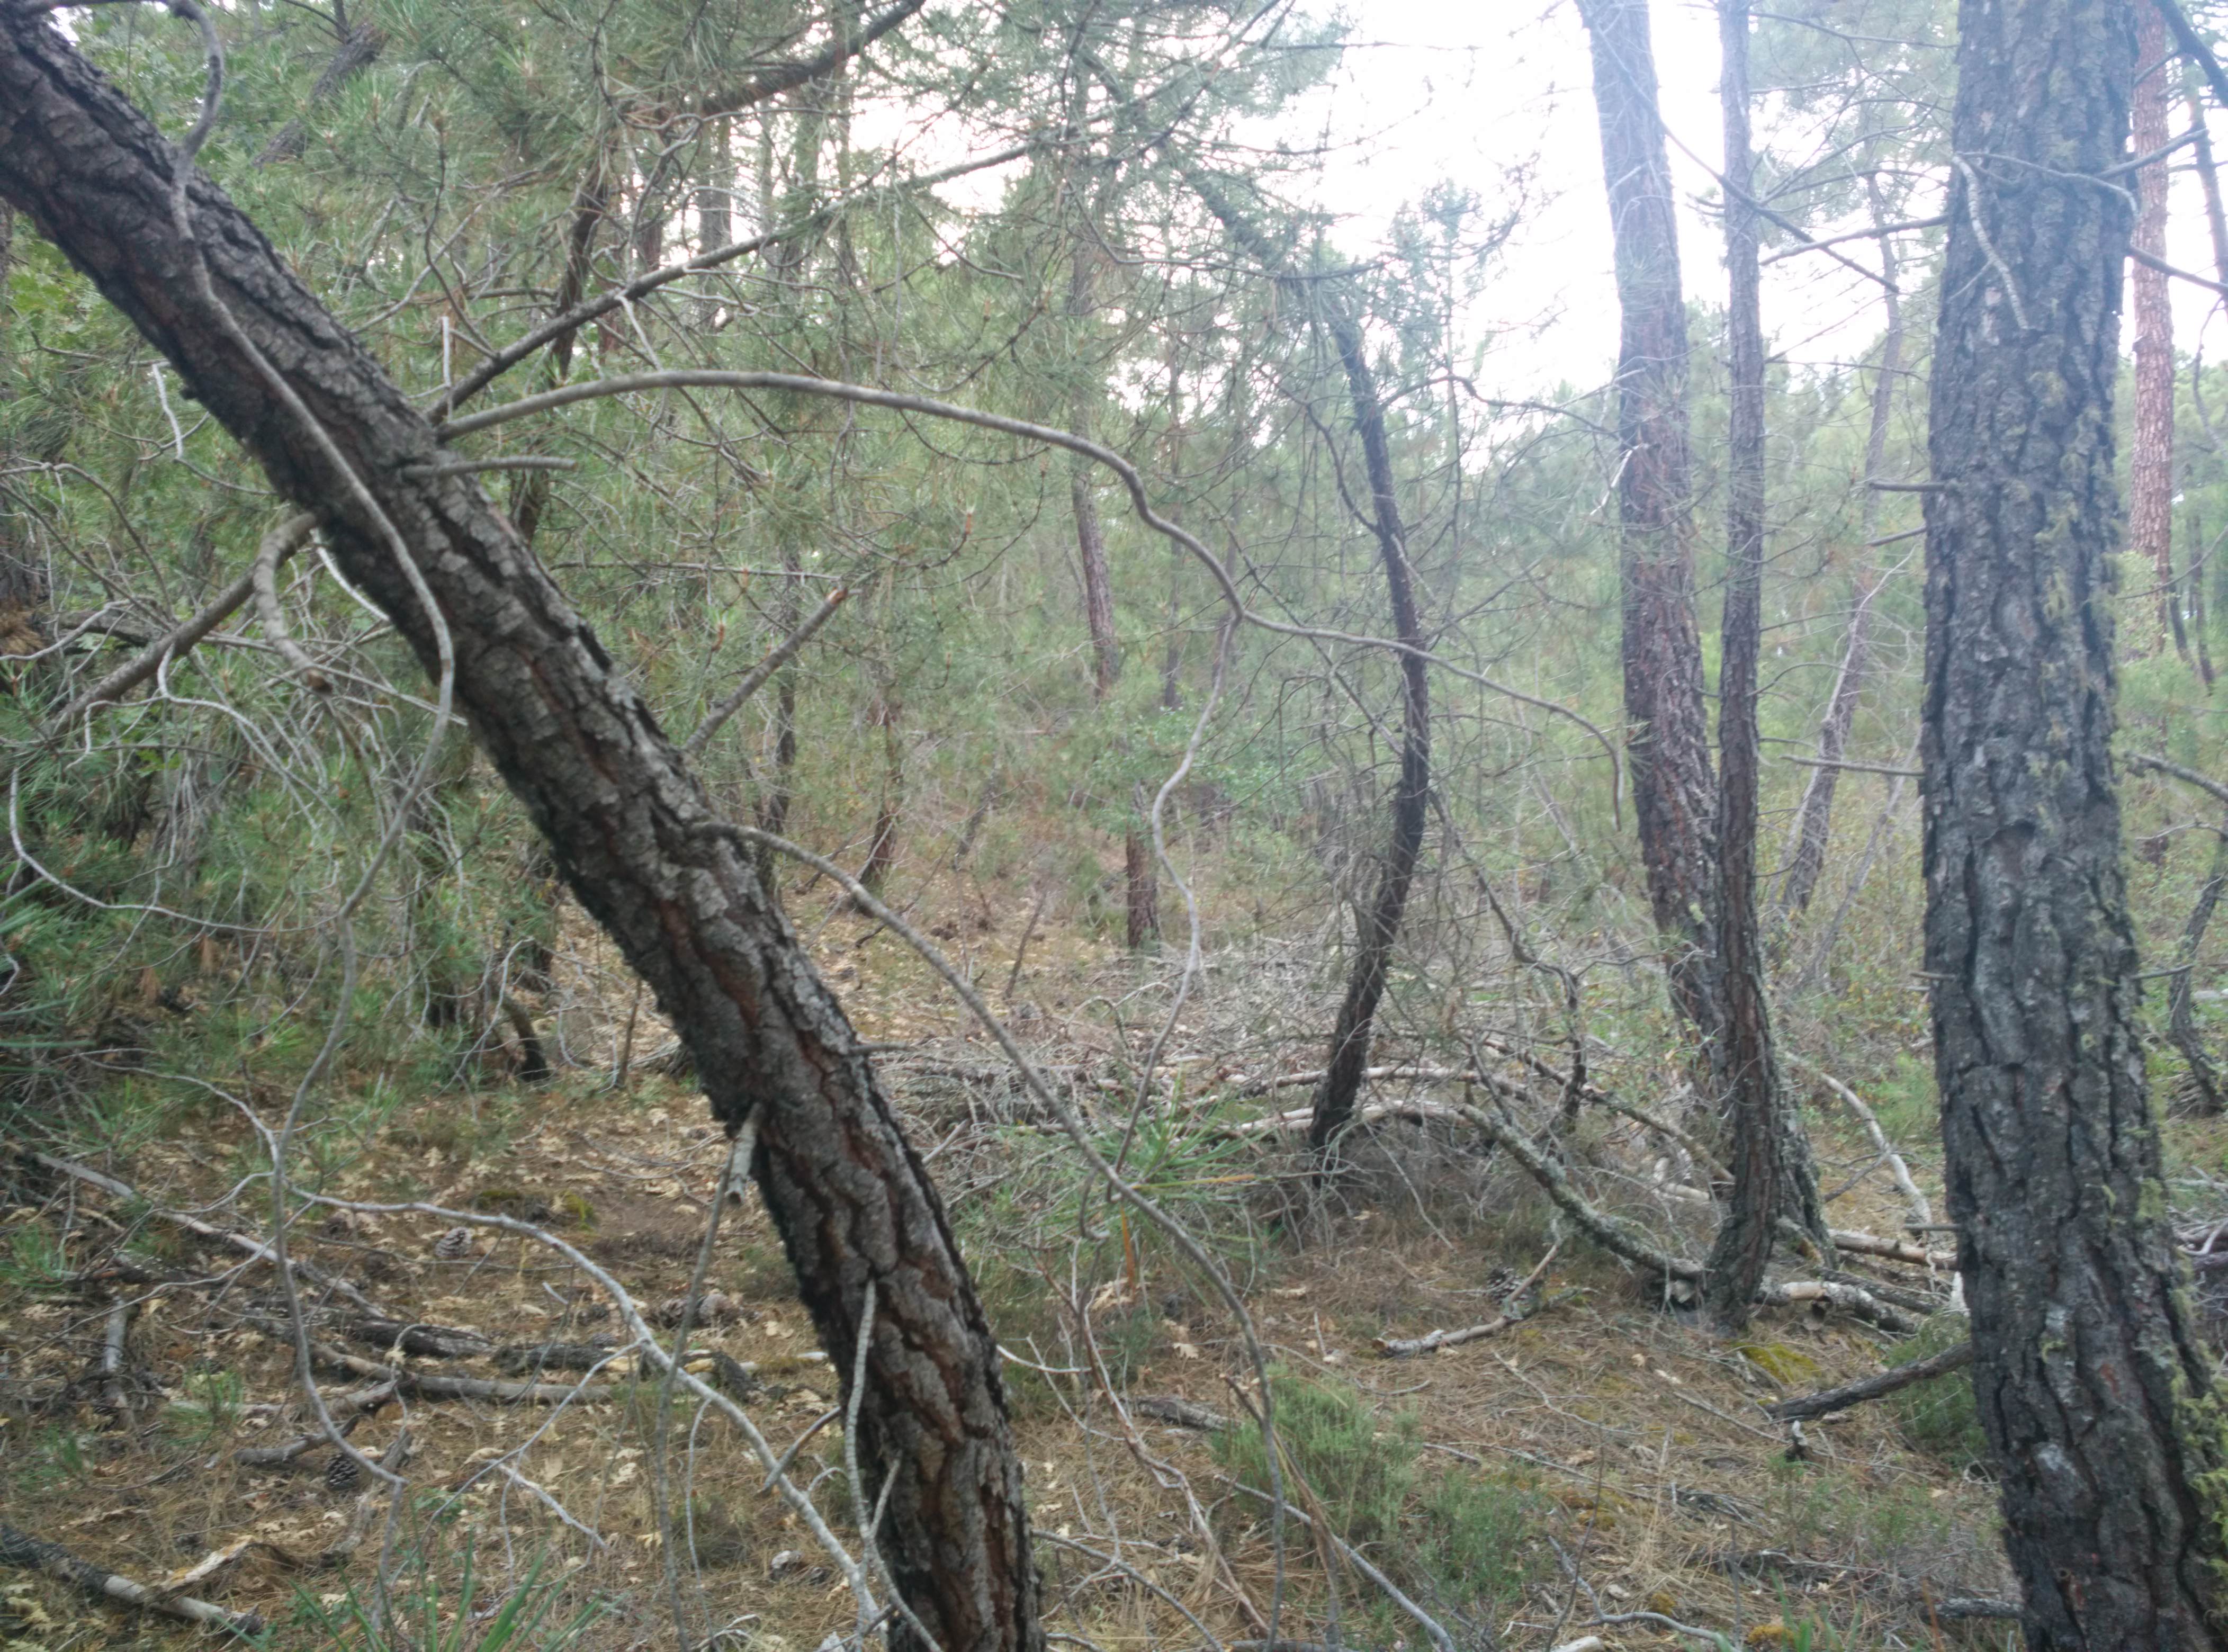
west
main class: Woodland
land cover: Pine dominated coniferous woodland
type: coniferous forest of the mediterranean region
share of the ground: 50 - 75 %
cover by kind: coniferous forest trees 70 %, shrubs 20 %, unconsolidated bare surface 10 %
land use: Semi-natural and natural areas not in use
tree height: > 5 m
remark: Clear cut
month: July
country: ES
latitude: 40.8591
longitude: -2.0174
